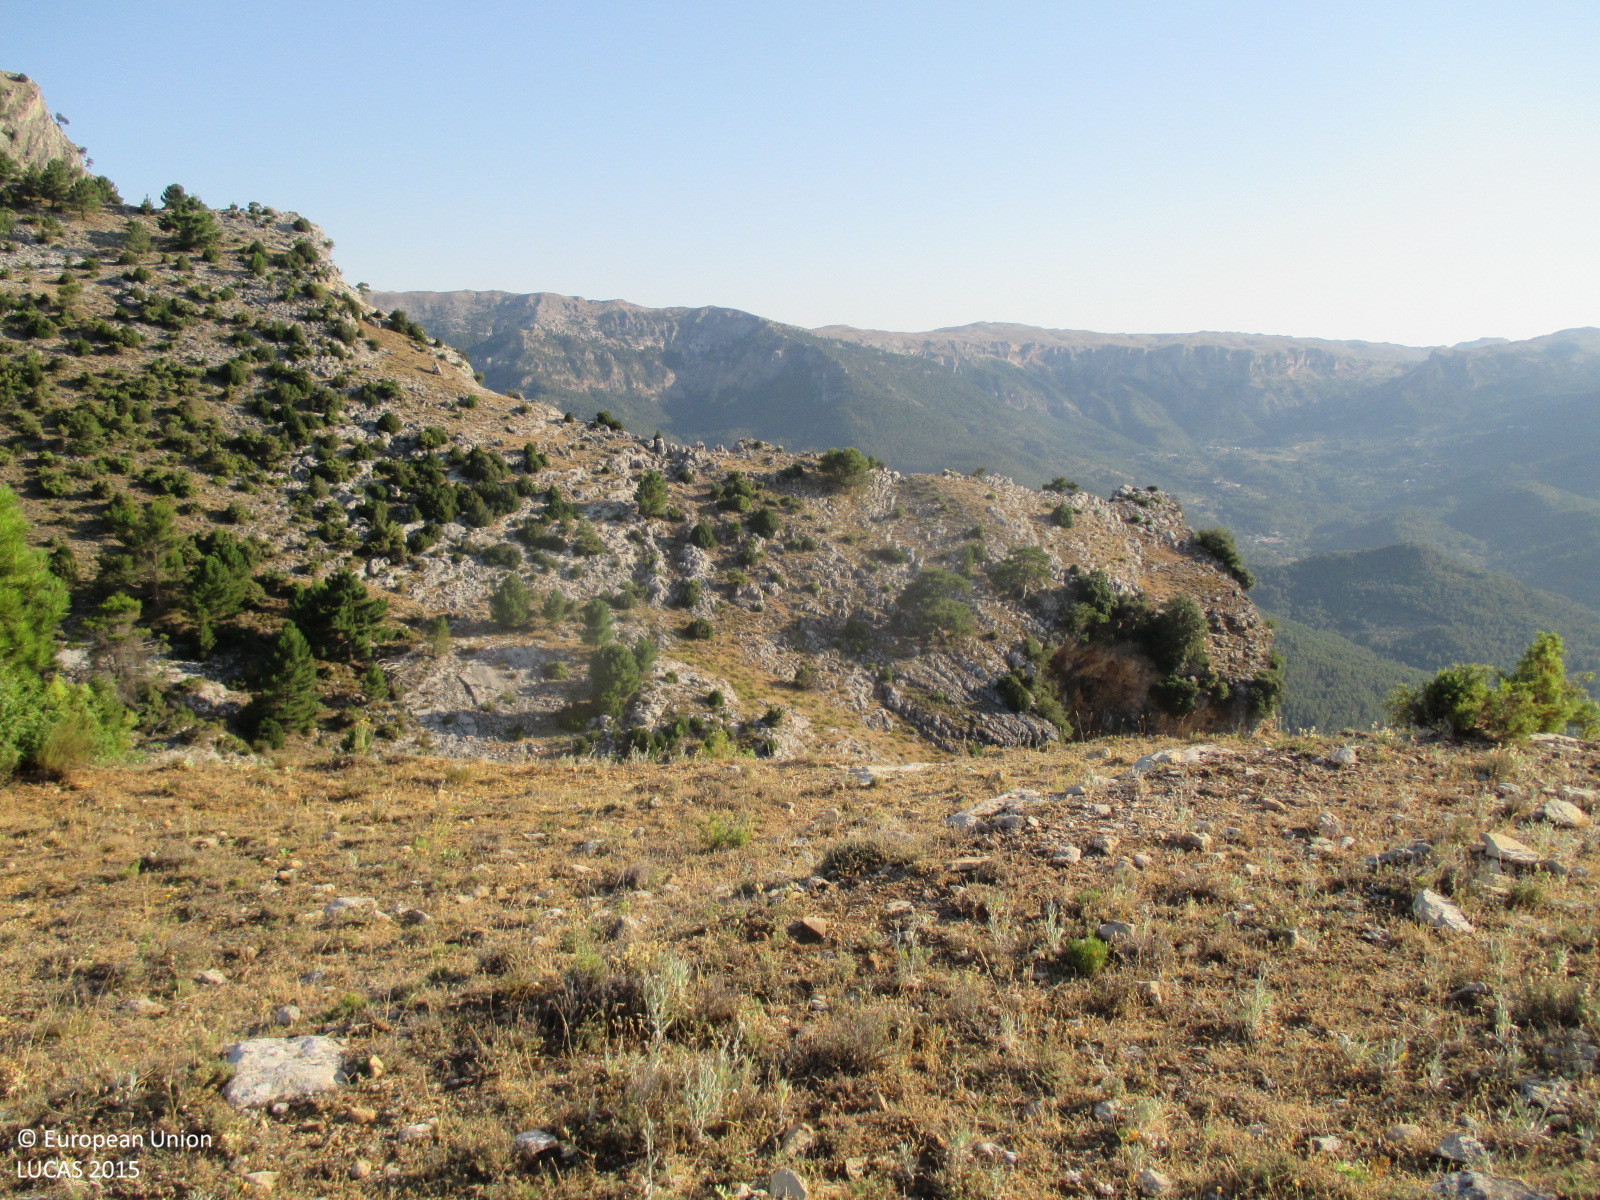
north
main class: Grassland
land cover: Grassland without tree/shrub cover
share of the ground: > 75 %
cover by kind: herbaceous plants 90 %, consolidated bare surface 10 %
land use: Semi-natural and natural areas not in use
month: July
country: ES
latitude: 38.3537
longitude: -2.4584
